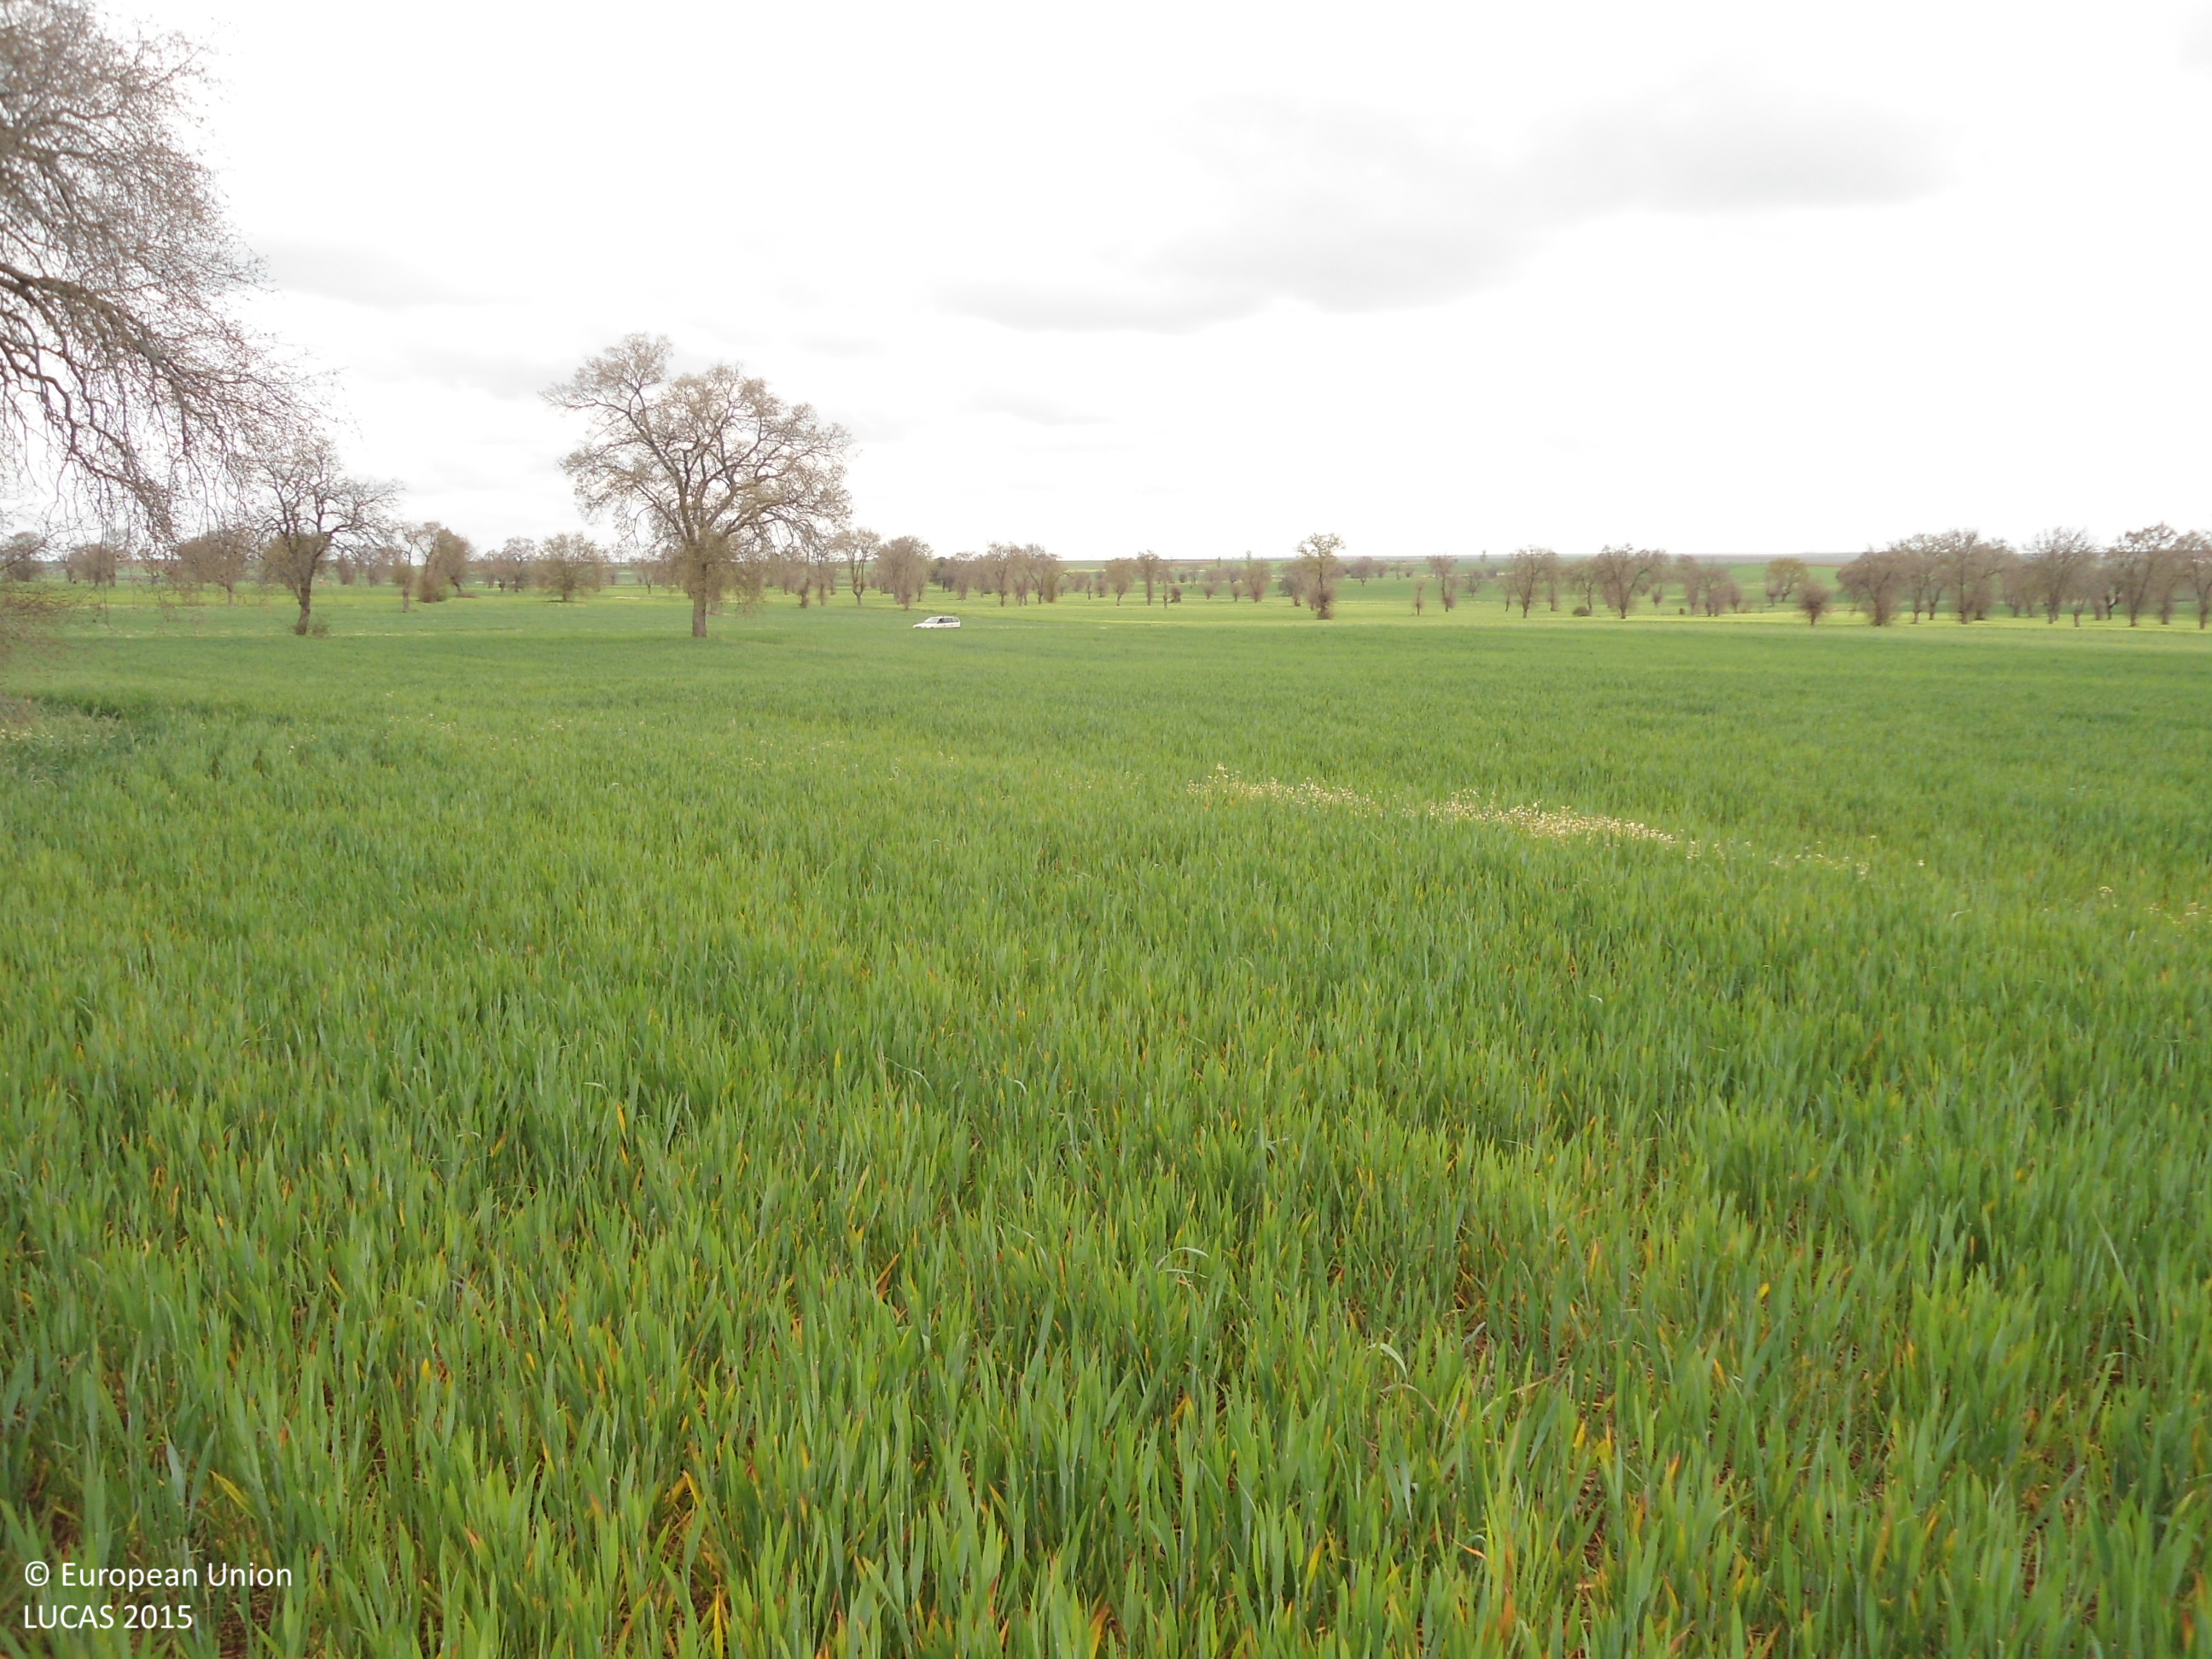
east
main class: Cropland
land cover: Common wheat
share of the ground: > 75 %
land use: Agriculture (excluding fallow land and kitchen gardens)
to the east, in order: Common wheat; Mixed cereals for fodder; Grass margins; Tracks; Grass margins; Barley
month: April
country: ES
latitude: 41.6138
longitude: -5.8712
